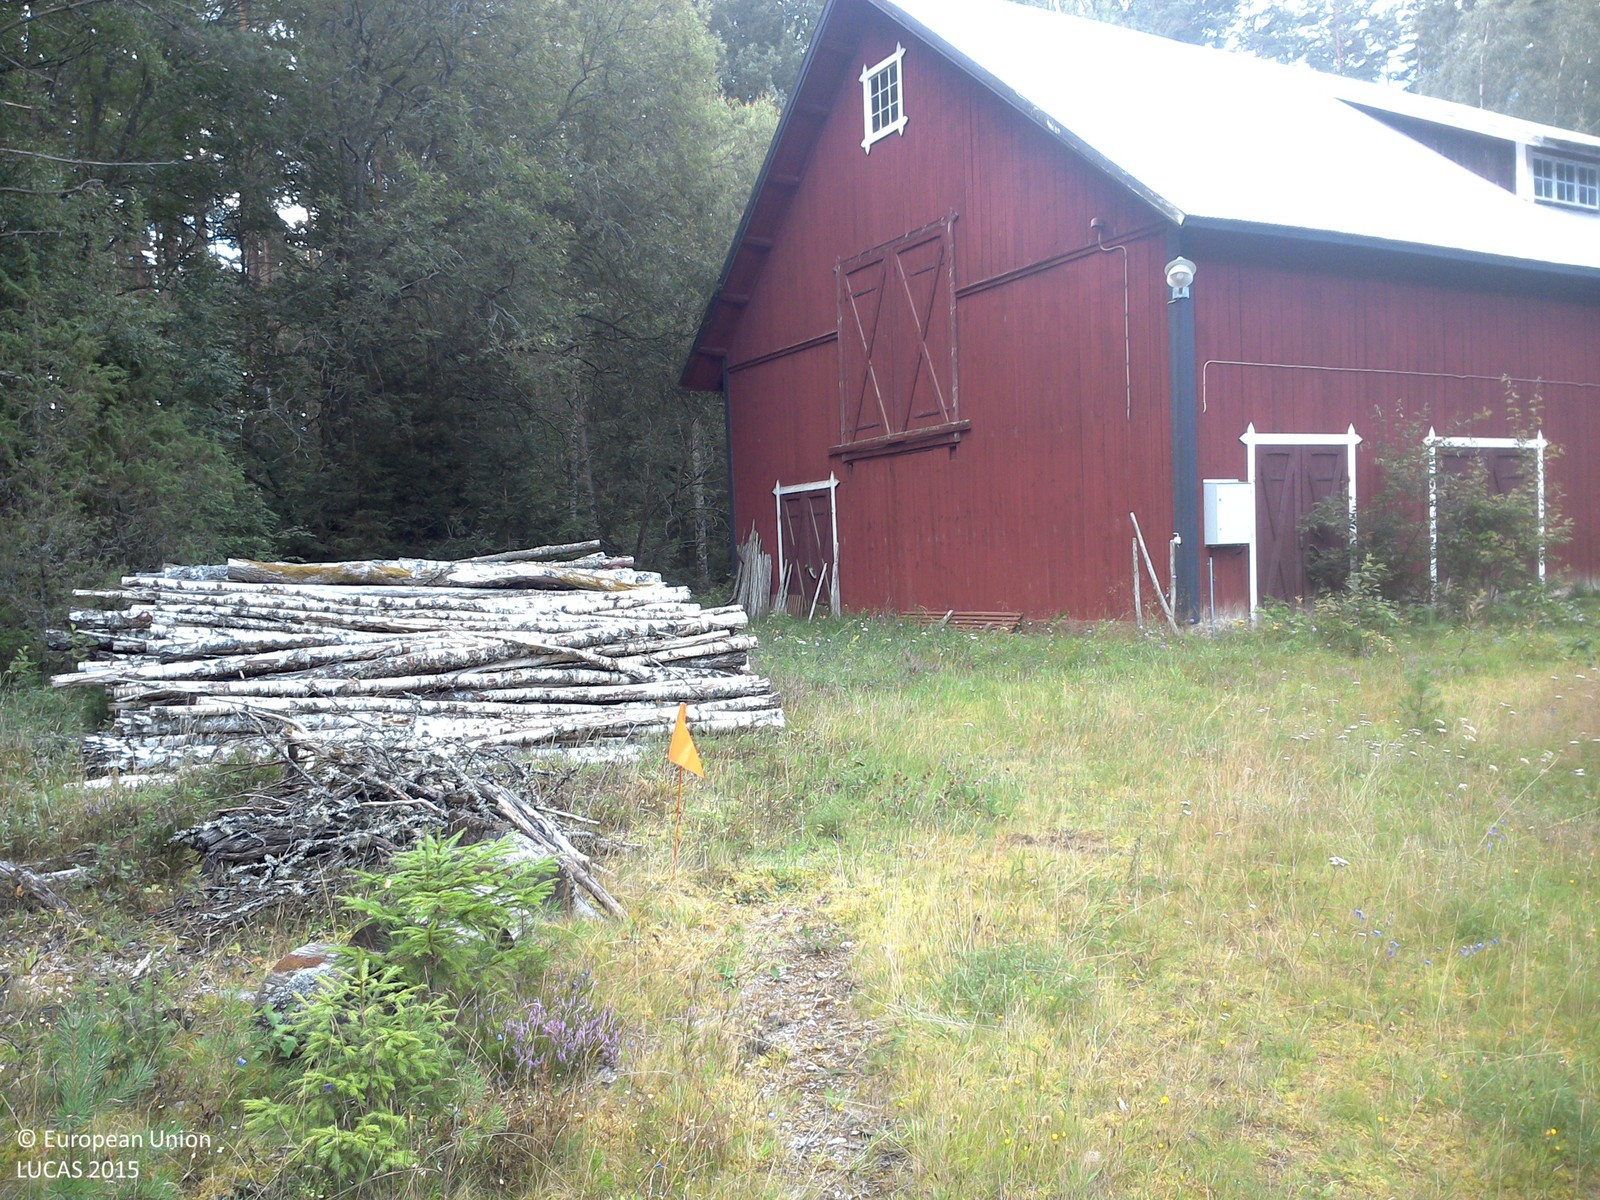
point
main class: Grassland
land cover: Grassland with sparse tree/shrub cover
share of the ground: > 75 %
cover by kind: herbaceous plants 90 %, coniferous forest trees 5 %, lichens and mosses 5 %
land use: Residential
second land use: Logistics and storage
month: August
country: SE
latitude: 57.8294
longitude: 15.6711
